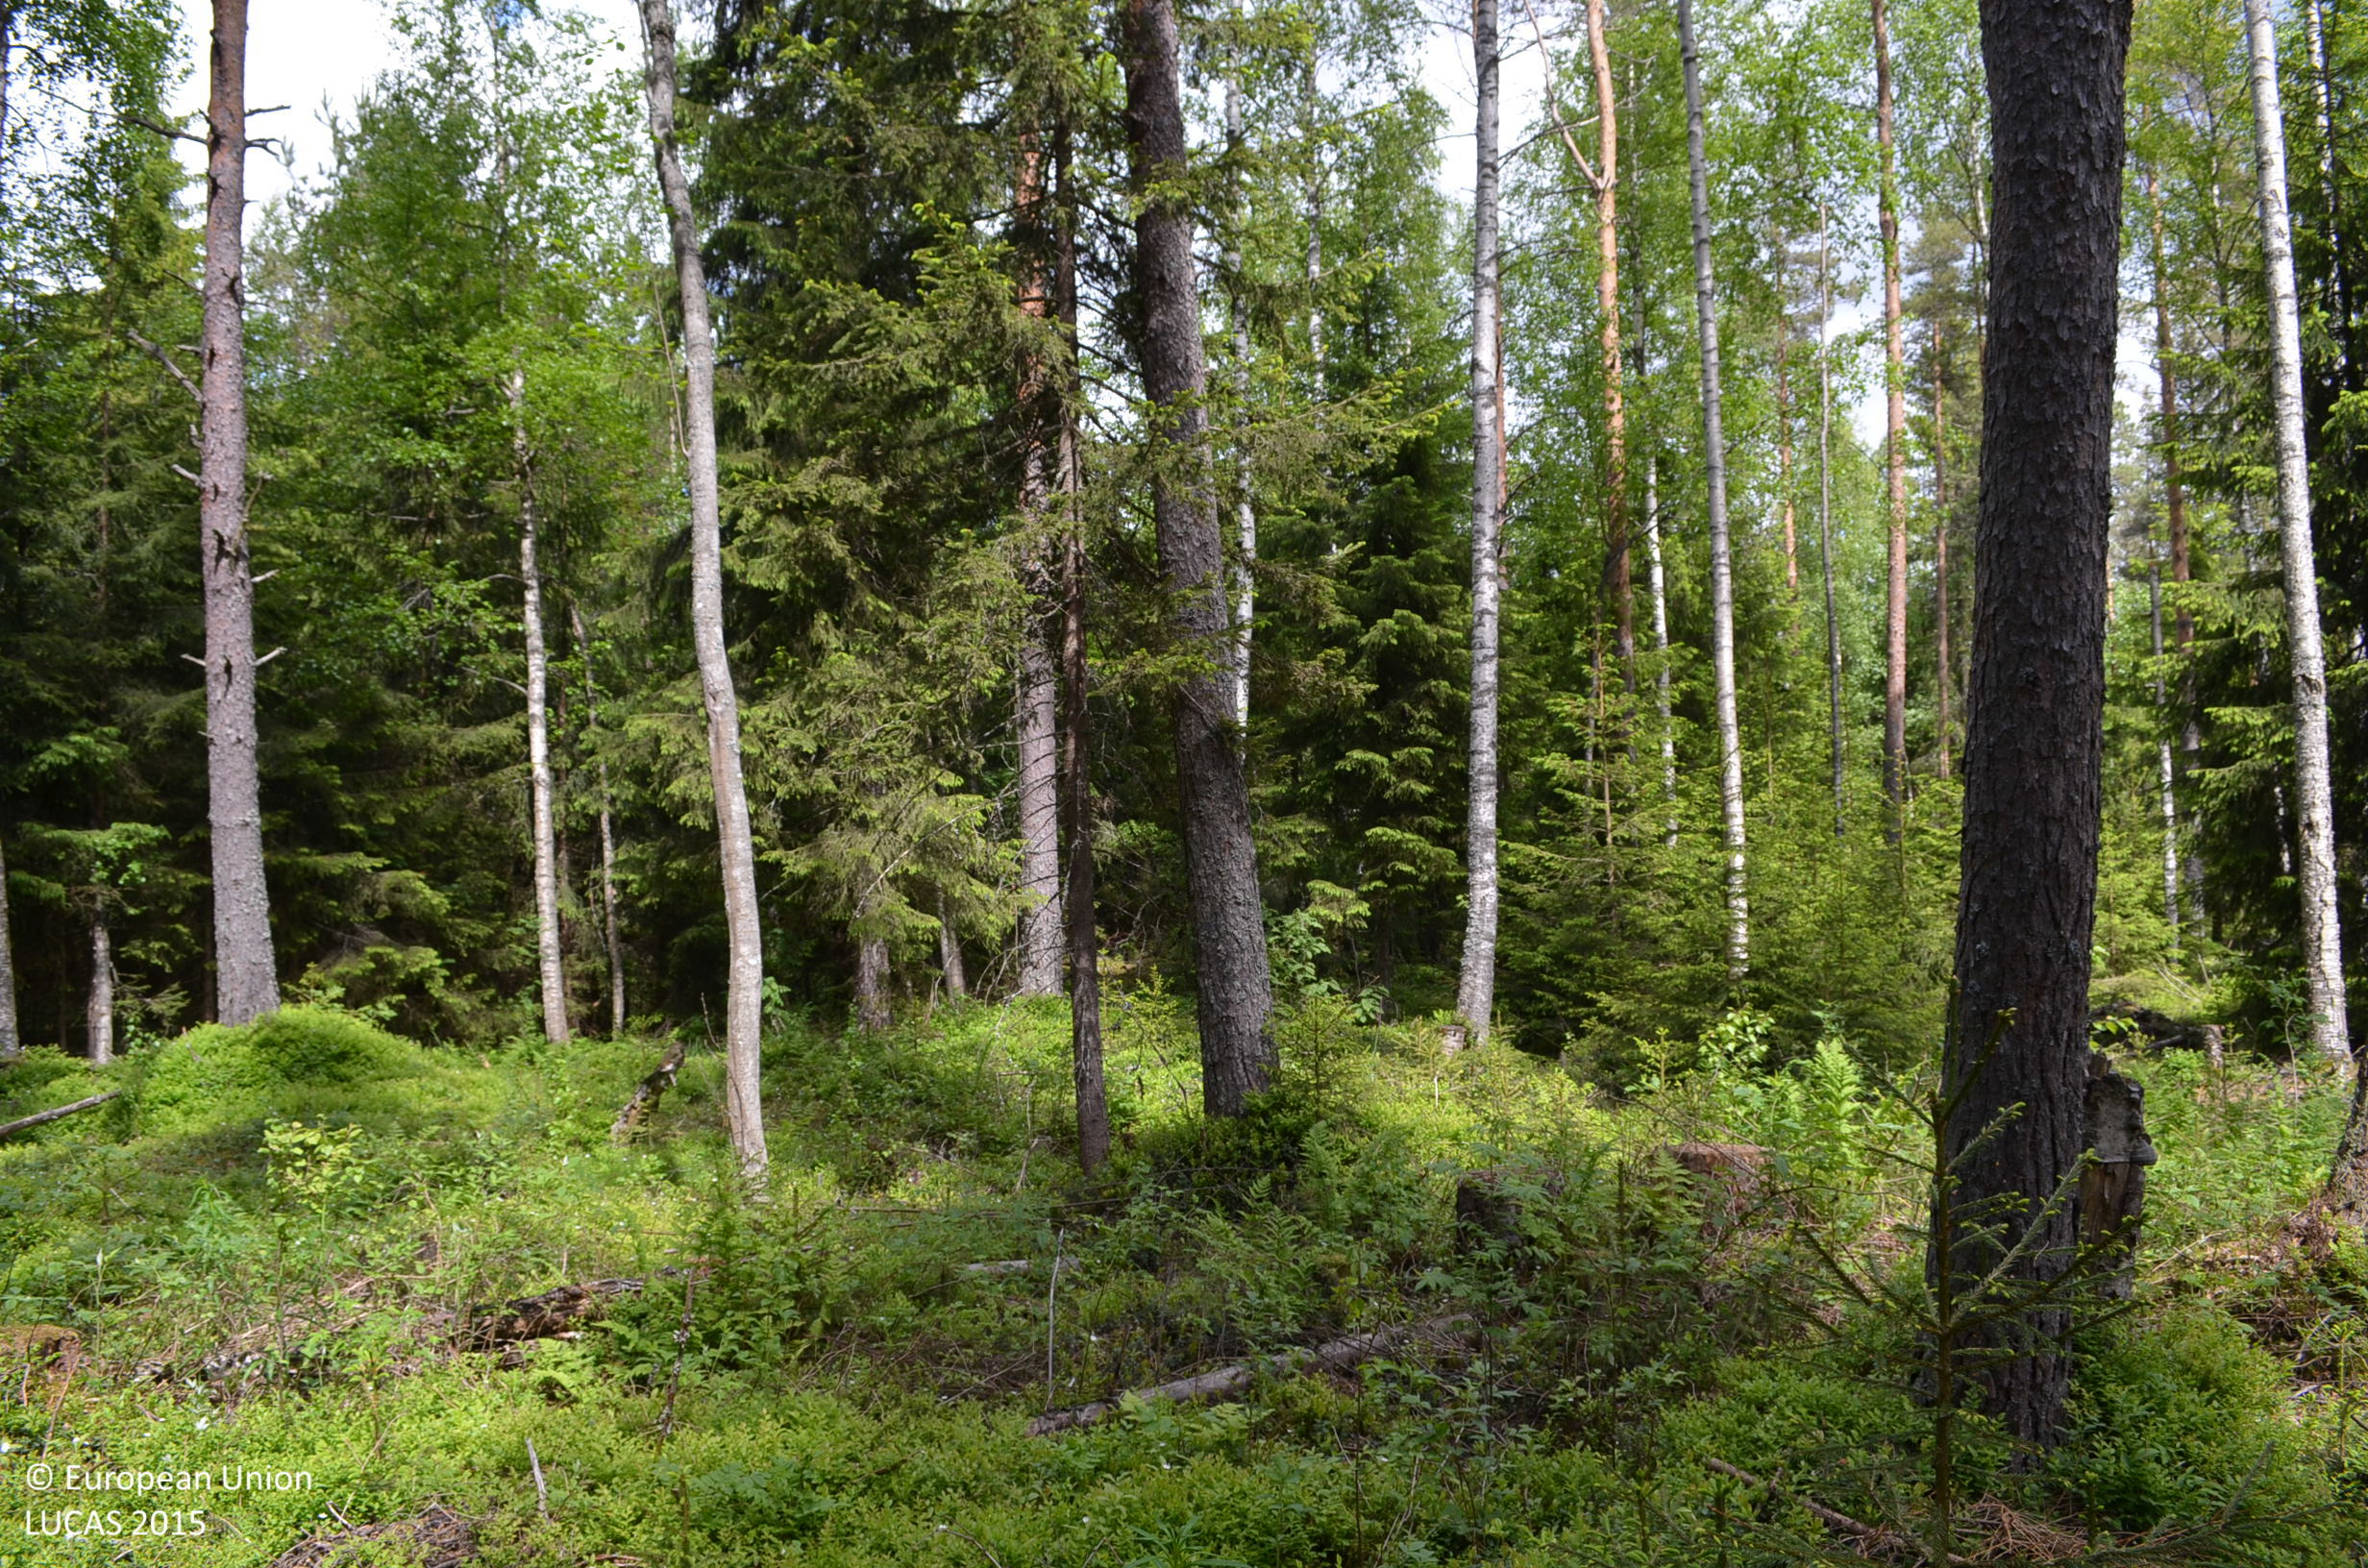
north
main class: Woodland
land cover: Other mixed woodland
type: boreal forest
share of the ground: > 75 %
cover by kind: coniferous forest trees 60 %, broadleaved forest trees 20 %, shrubs 20 %
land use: Forestry
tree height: > 5 m
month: June
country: FI
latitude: 61.9759
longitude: 23.3712
